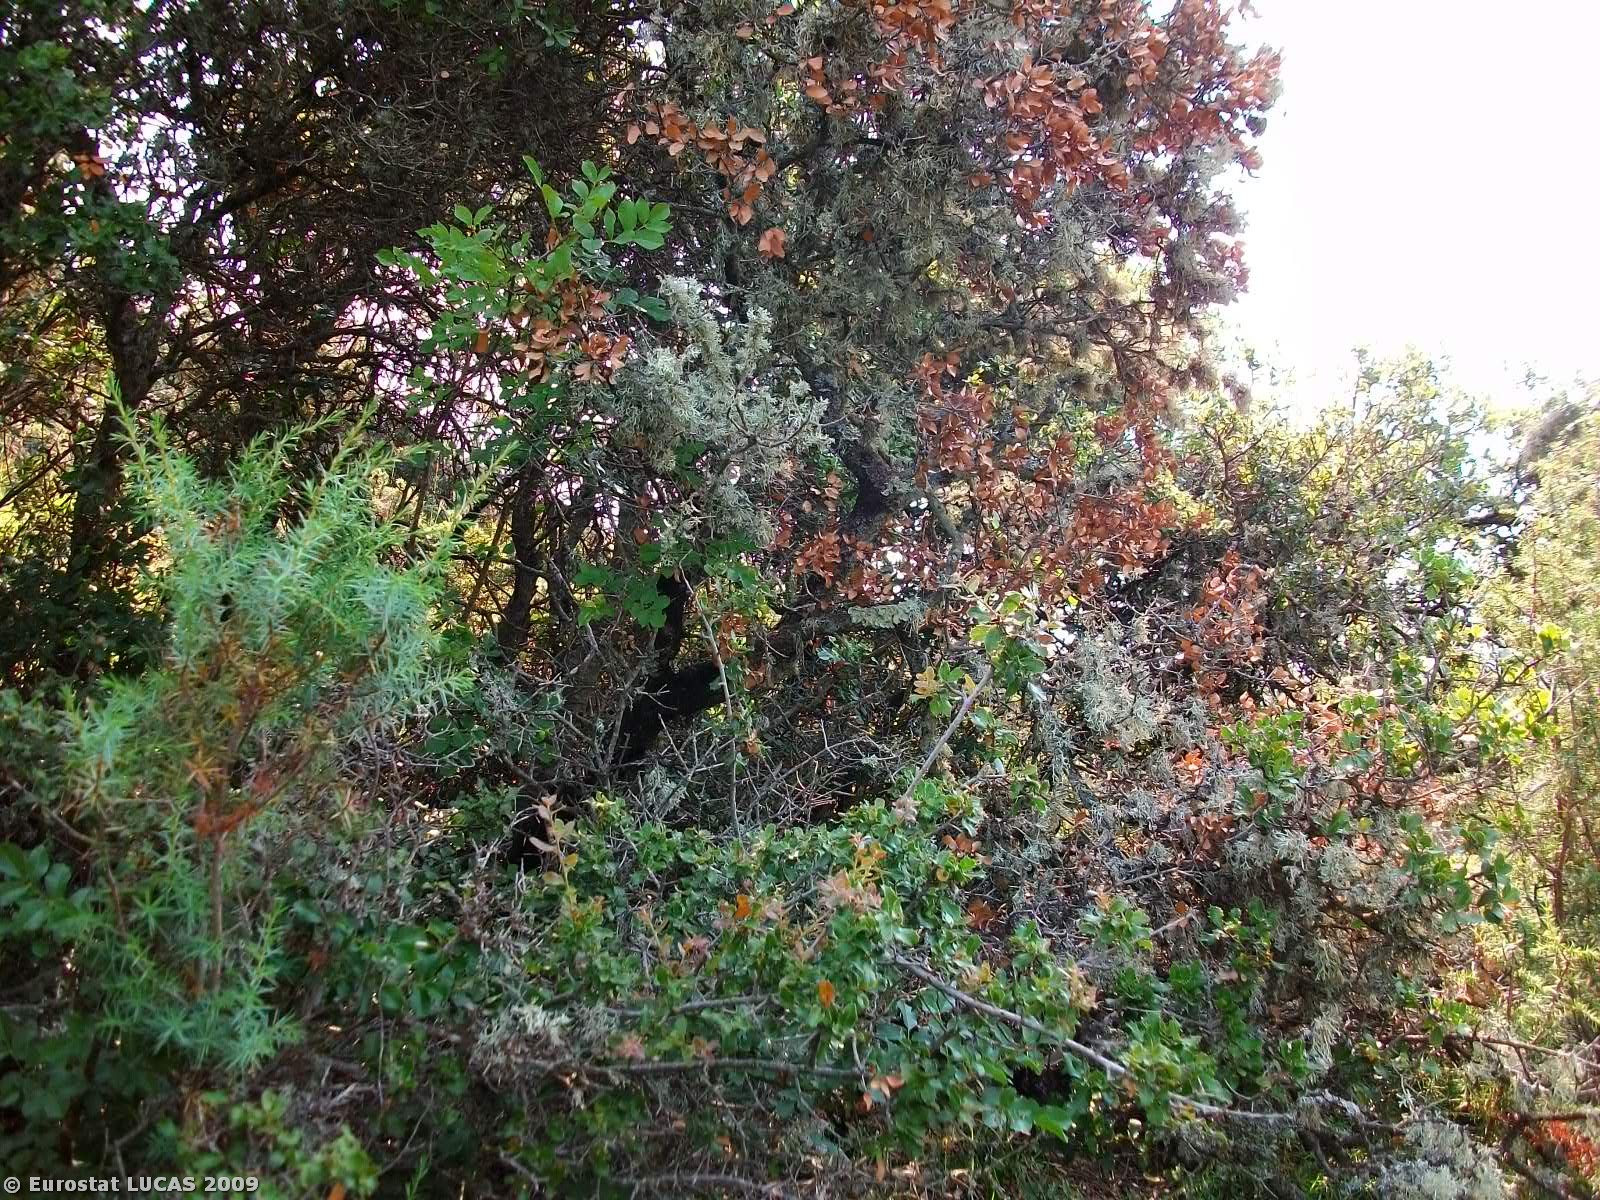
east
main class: Shrubland
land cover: Shrubland with sparse tree cover
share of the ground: > 75 %
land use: Unused
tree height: < 5 m
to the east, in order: Shrubland with sparse tree cover; Rock outcrops; Shrubland with sparse tree cover; Rock outcrops; Shrubland without tree cover; Electric lines; Rock outcrops; Shrubland without tree cover; Grassland without tree/shrub cover
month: July
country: GR
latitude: 41.0806
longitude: 24.4478
